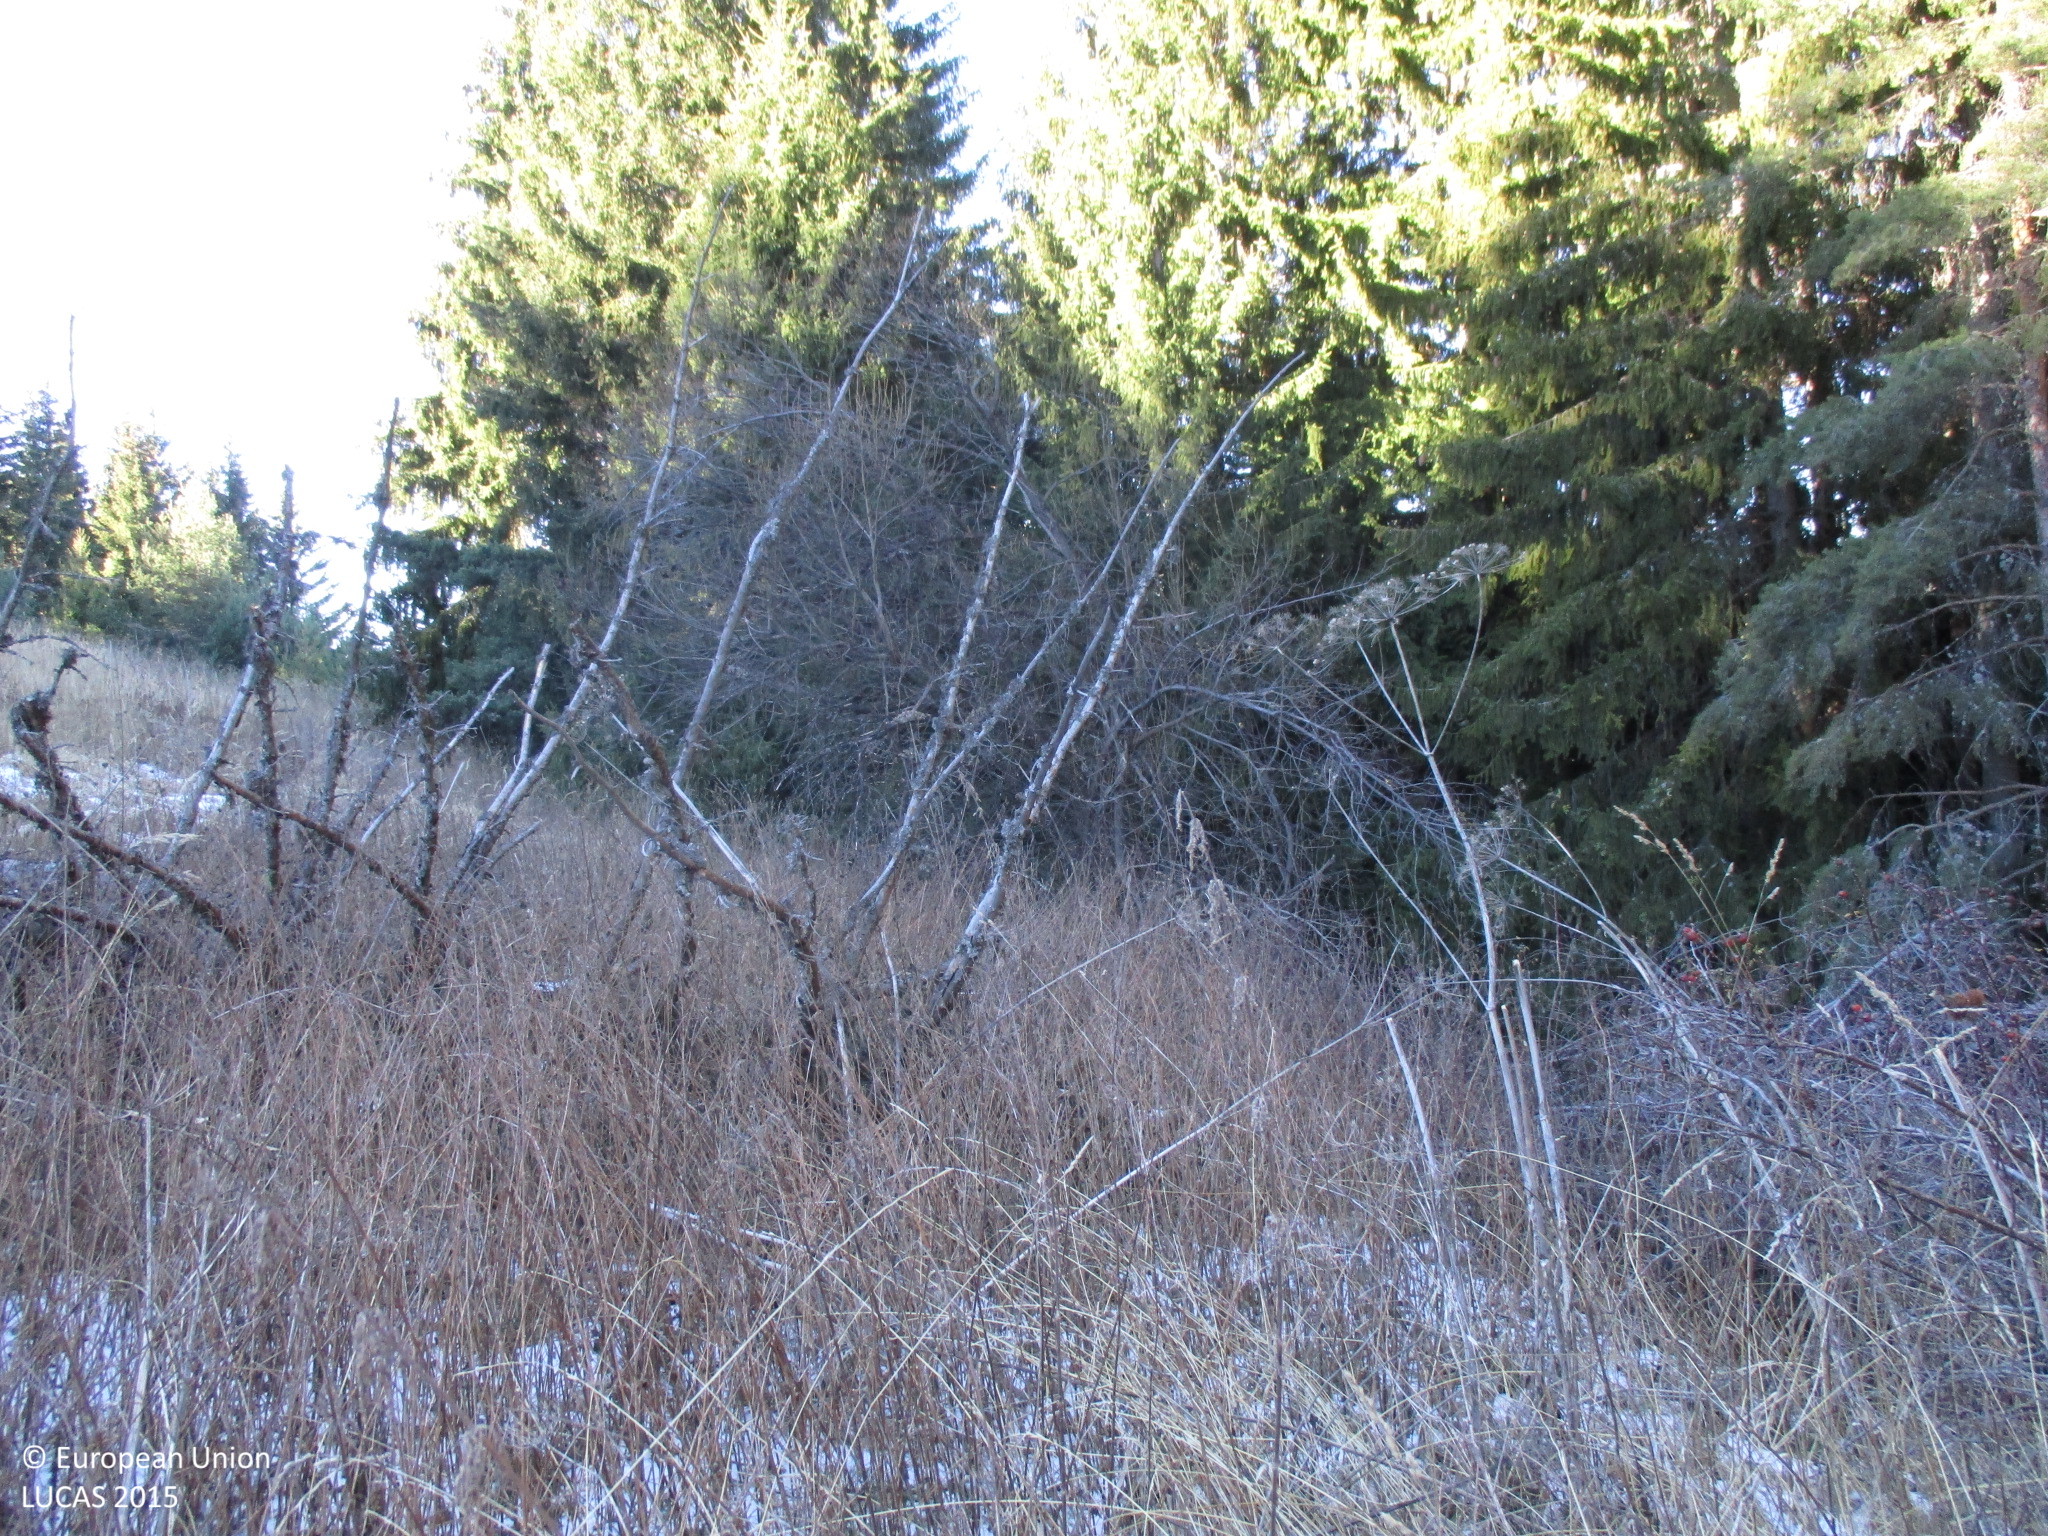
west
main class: Woodland
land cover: Spruce dominated coniferous woodland
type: alpine coniferous forest
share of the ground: > 75 %
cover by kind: coniferous forest trees 100 %
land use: Forestry
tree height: > 5 m
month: December
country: BG
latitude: 41.9195
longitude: 24.5997
